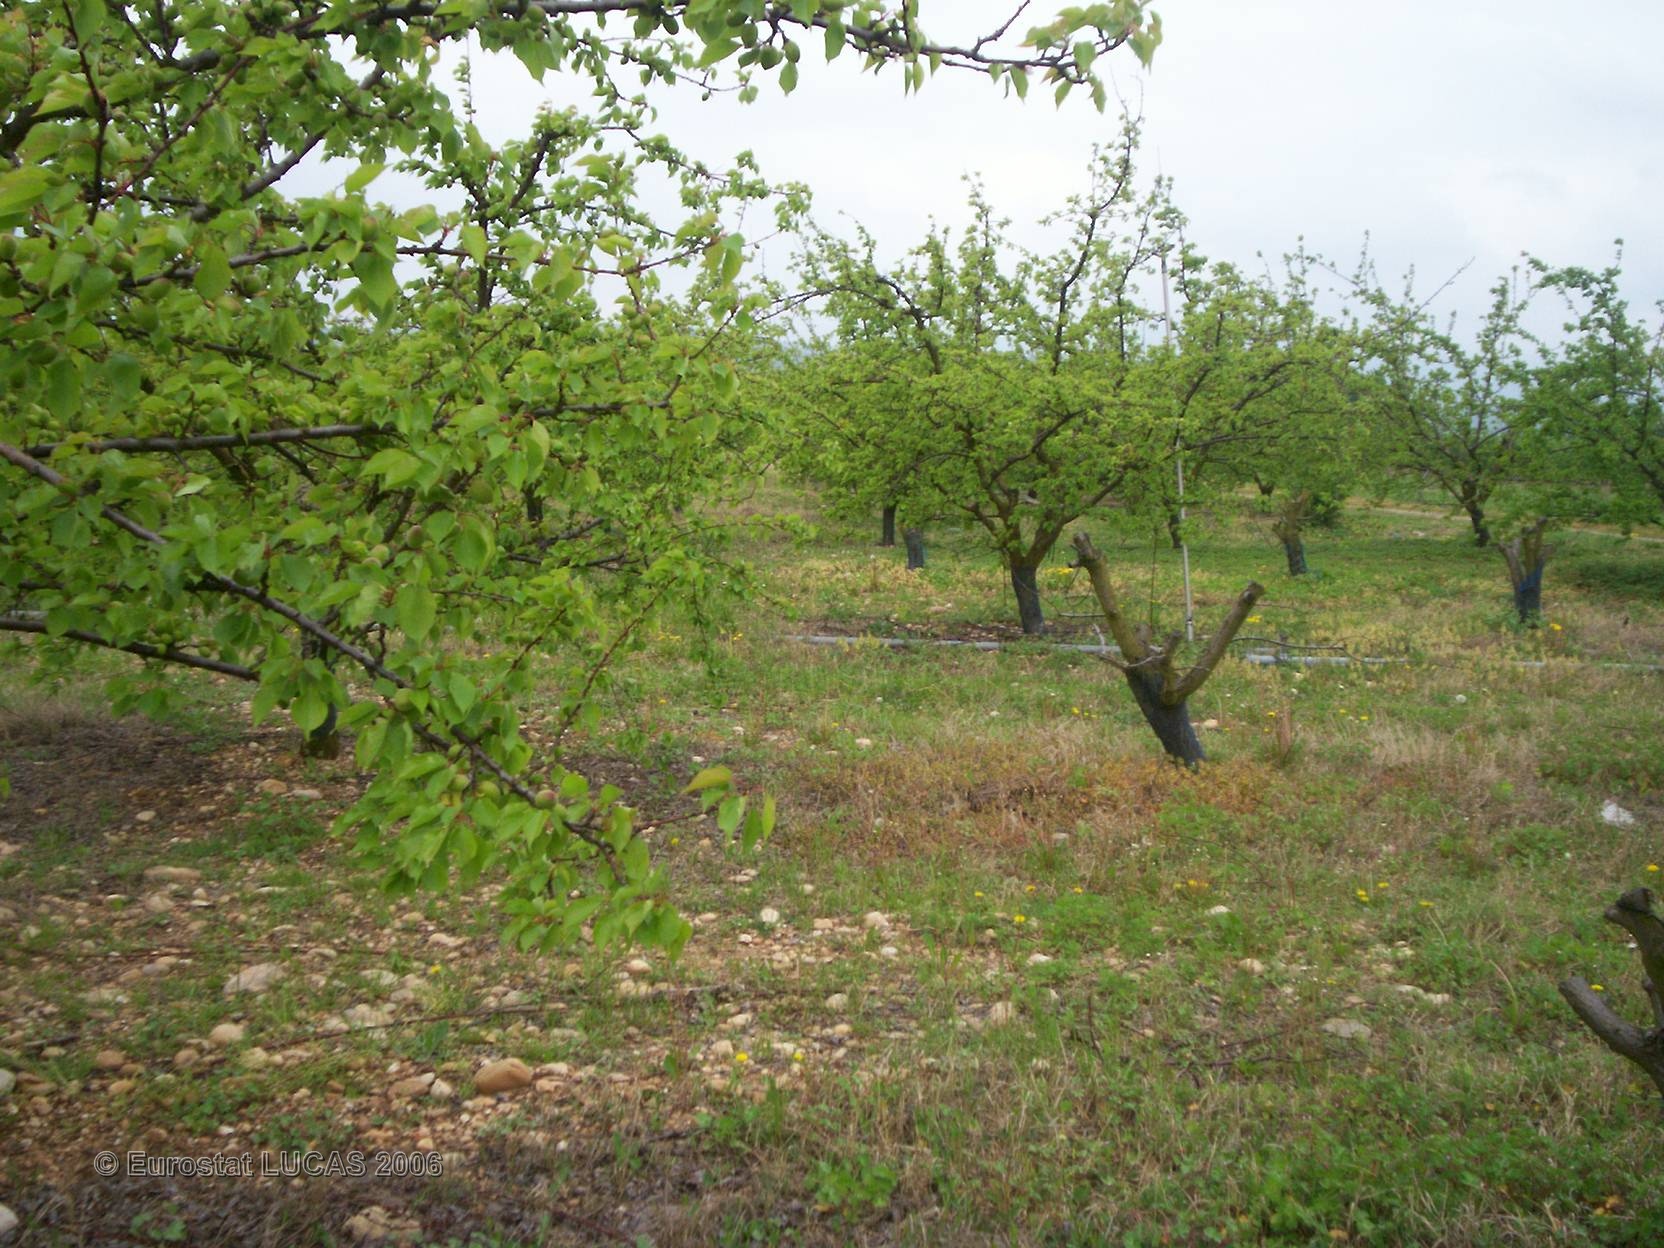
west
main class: Cropland
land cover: Other fruit trees and berries
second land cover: Grassland with sparse tree/shrub cover
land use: Agriculture (excluding fallow land and kitchen gardens)
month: April
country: FR
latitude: 45.3754
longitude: 4.7817
